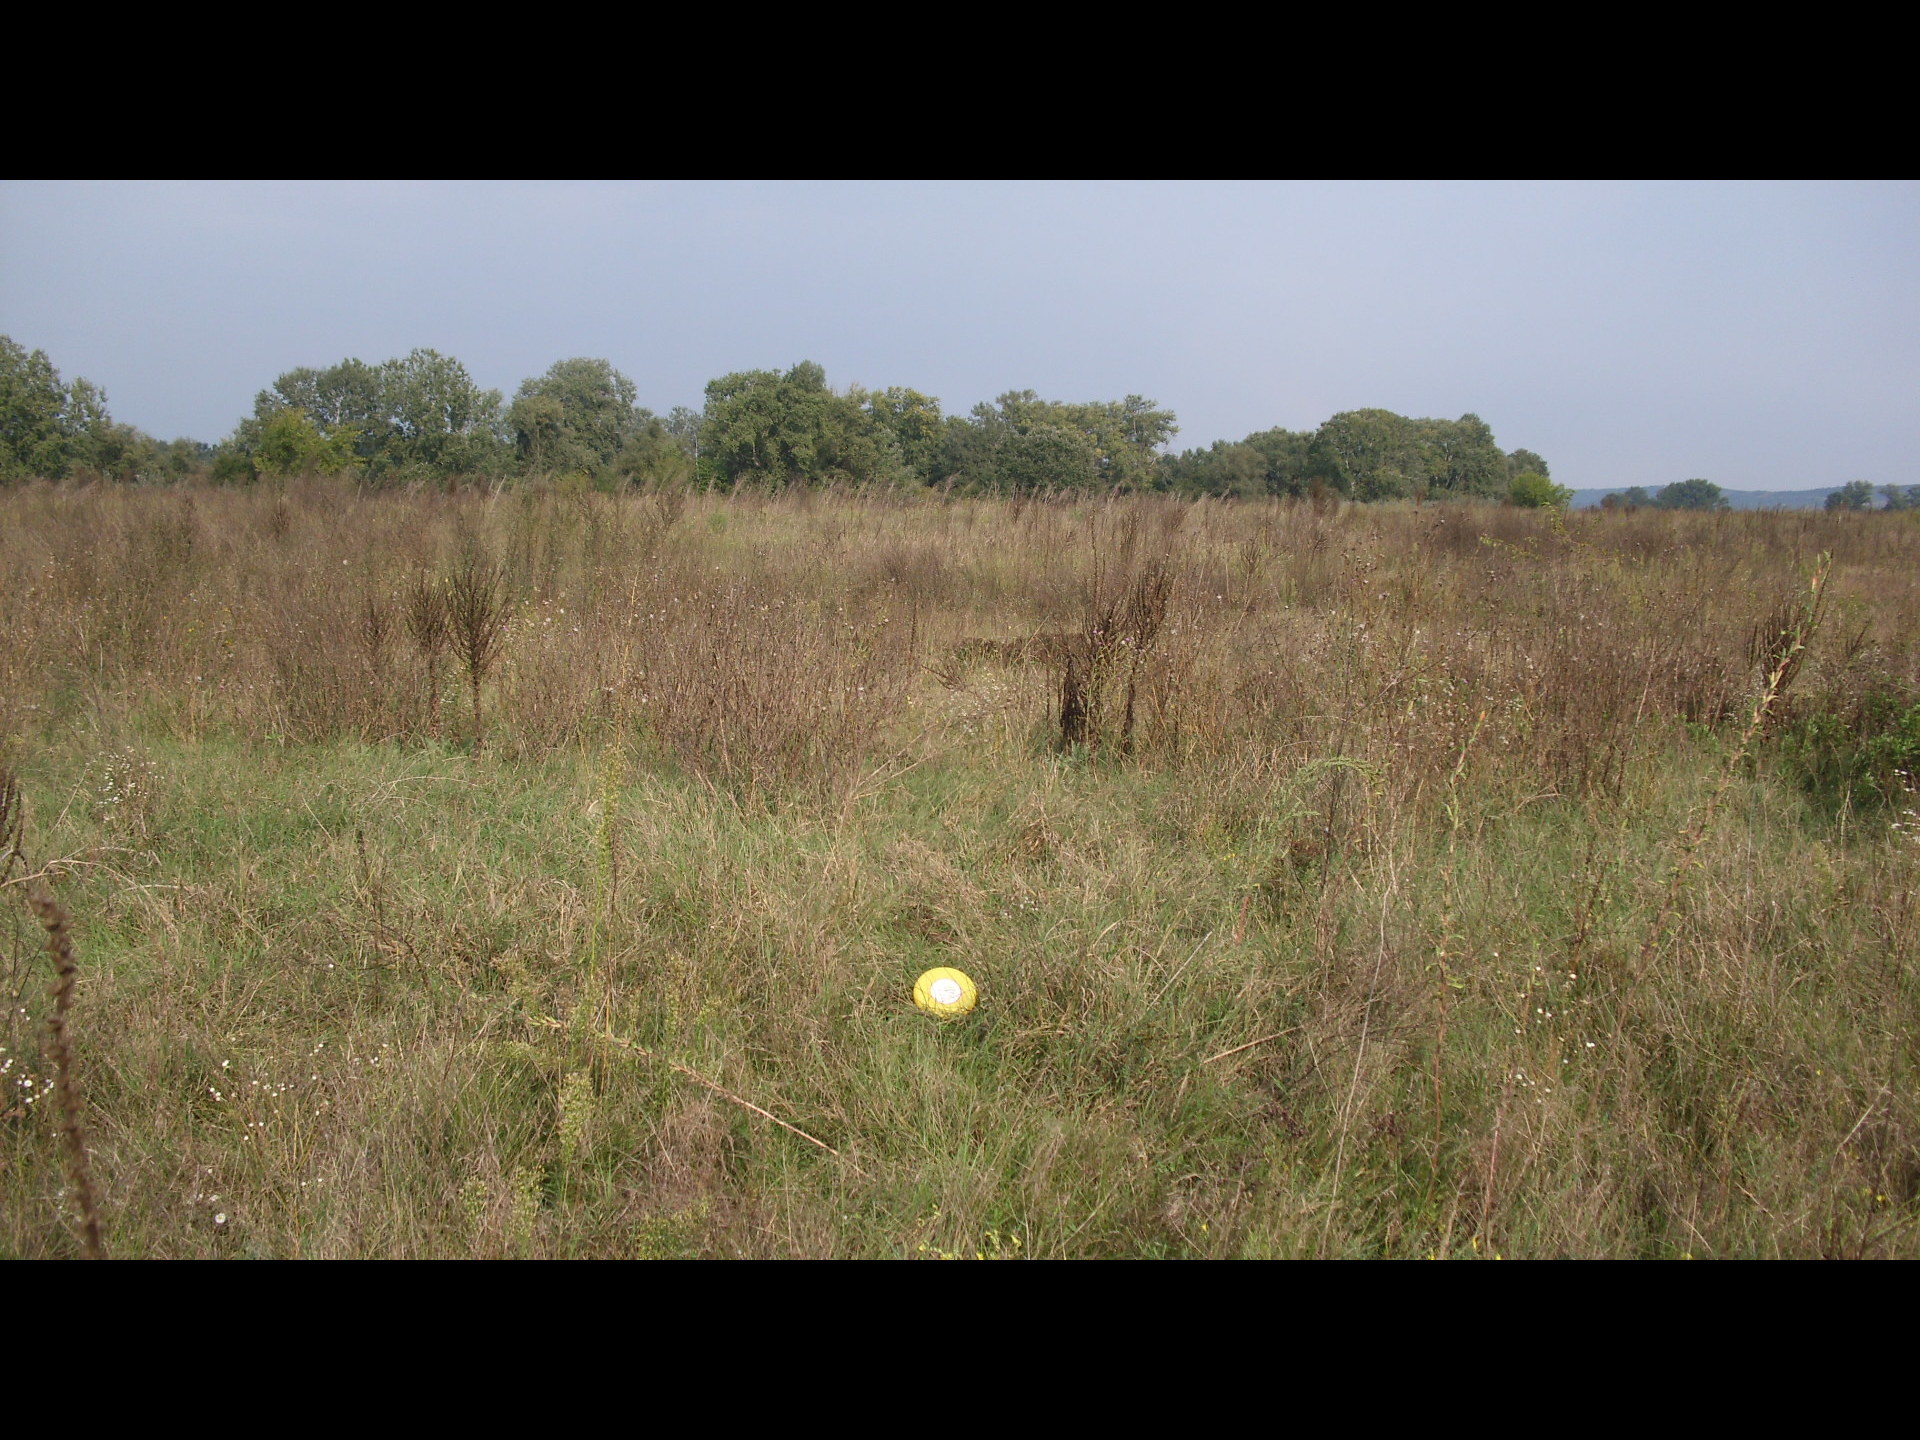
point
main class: Grassland
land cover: Spontaneously vegetated surfaces
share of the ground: > 75 %
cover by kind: herbaceous plants 100 %
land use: Abandoned areas
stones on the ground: < 10 %
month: September
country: BG
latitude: 43.7813
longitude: 23.0244
